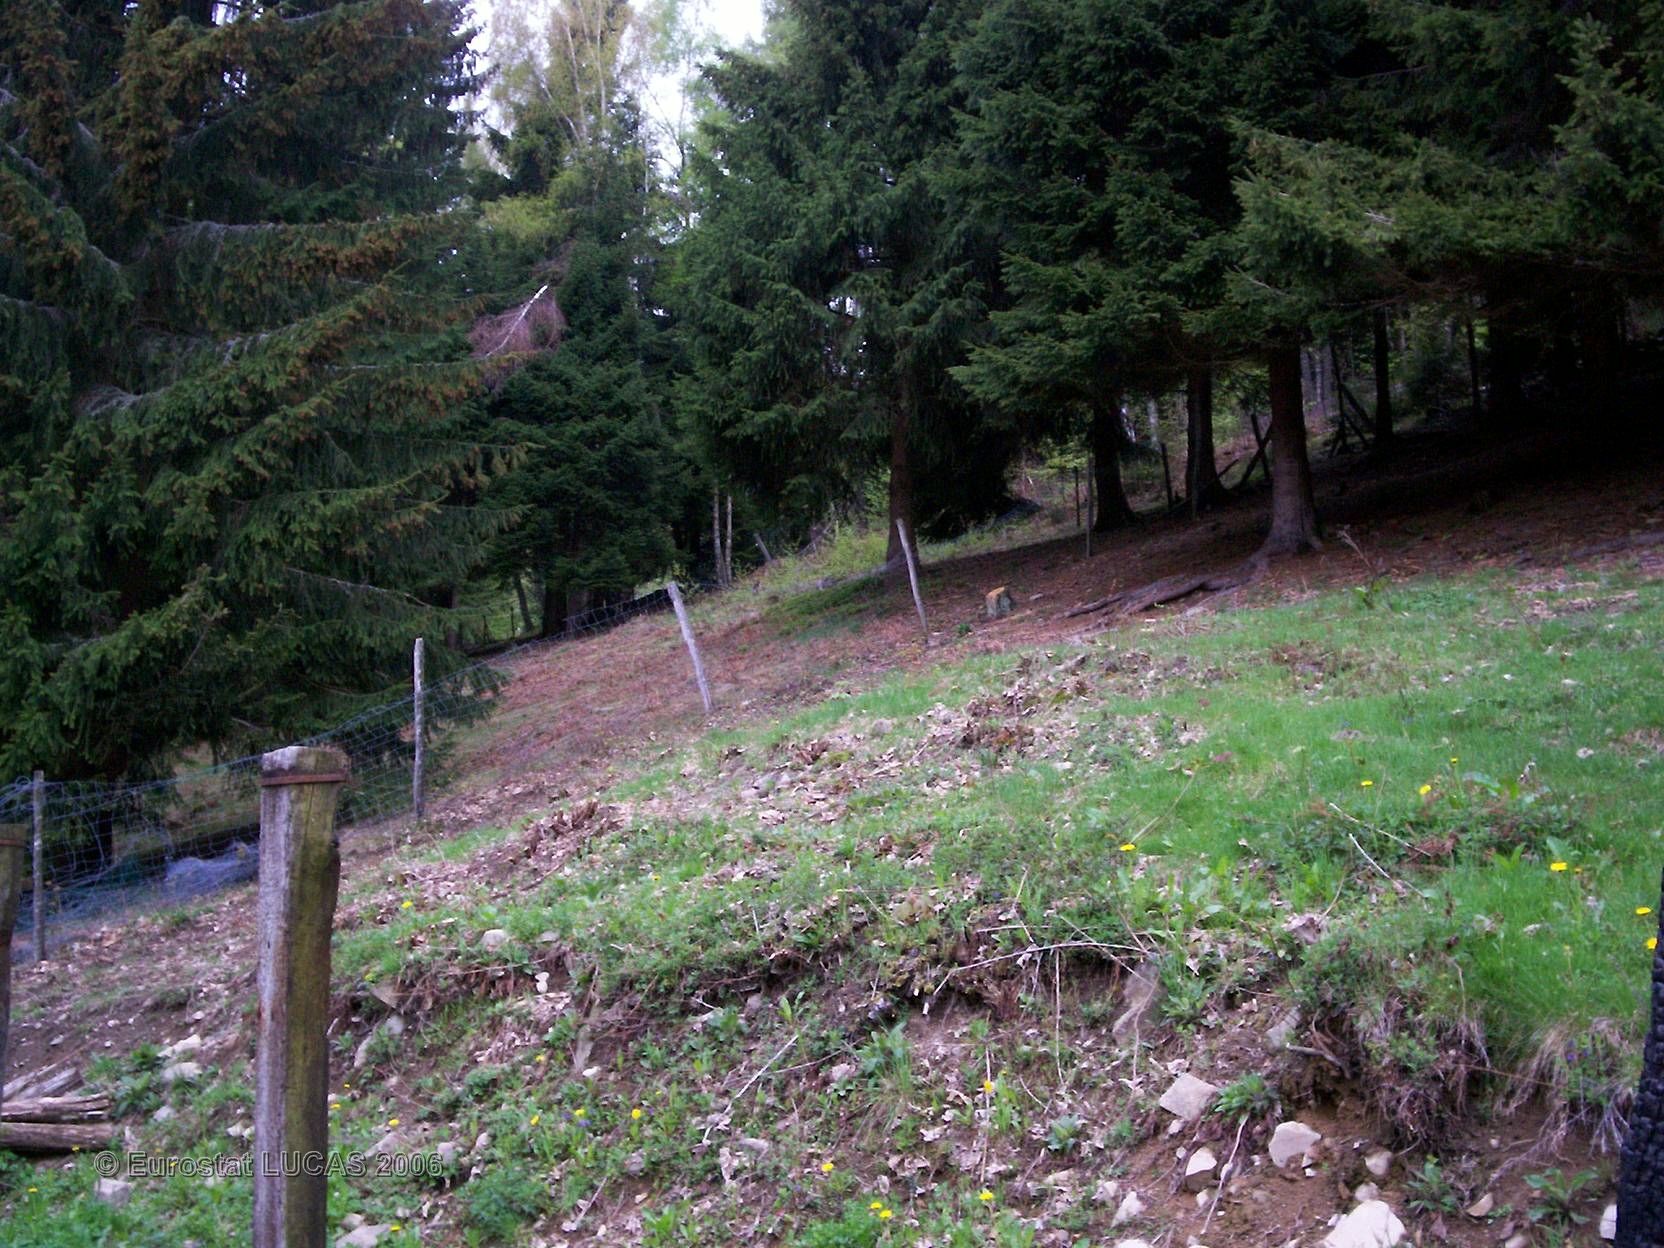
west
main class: Grassland
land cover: Grassland with sparse tree/shrub cover
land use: Agriculture (excluding fallow land and kitchen gardens)
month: May
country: FR
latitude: 47.9512
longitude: 7.0956
